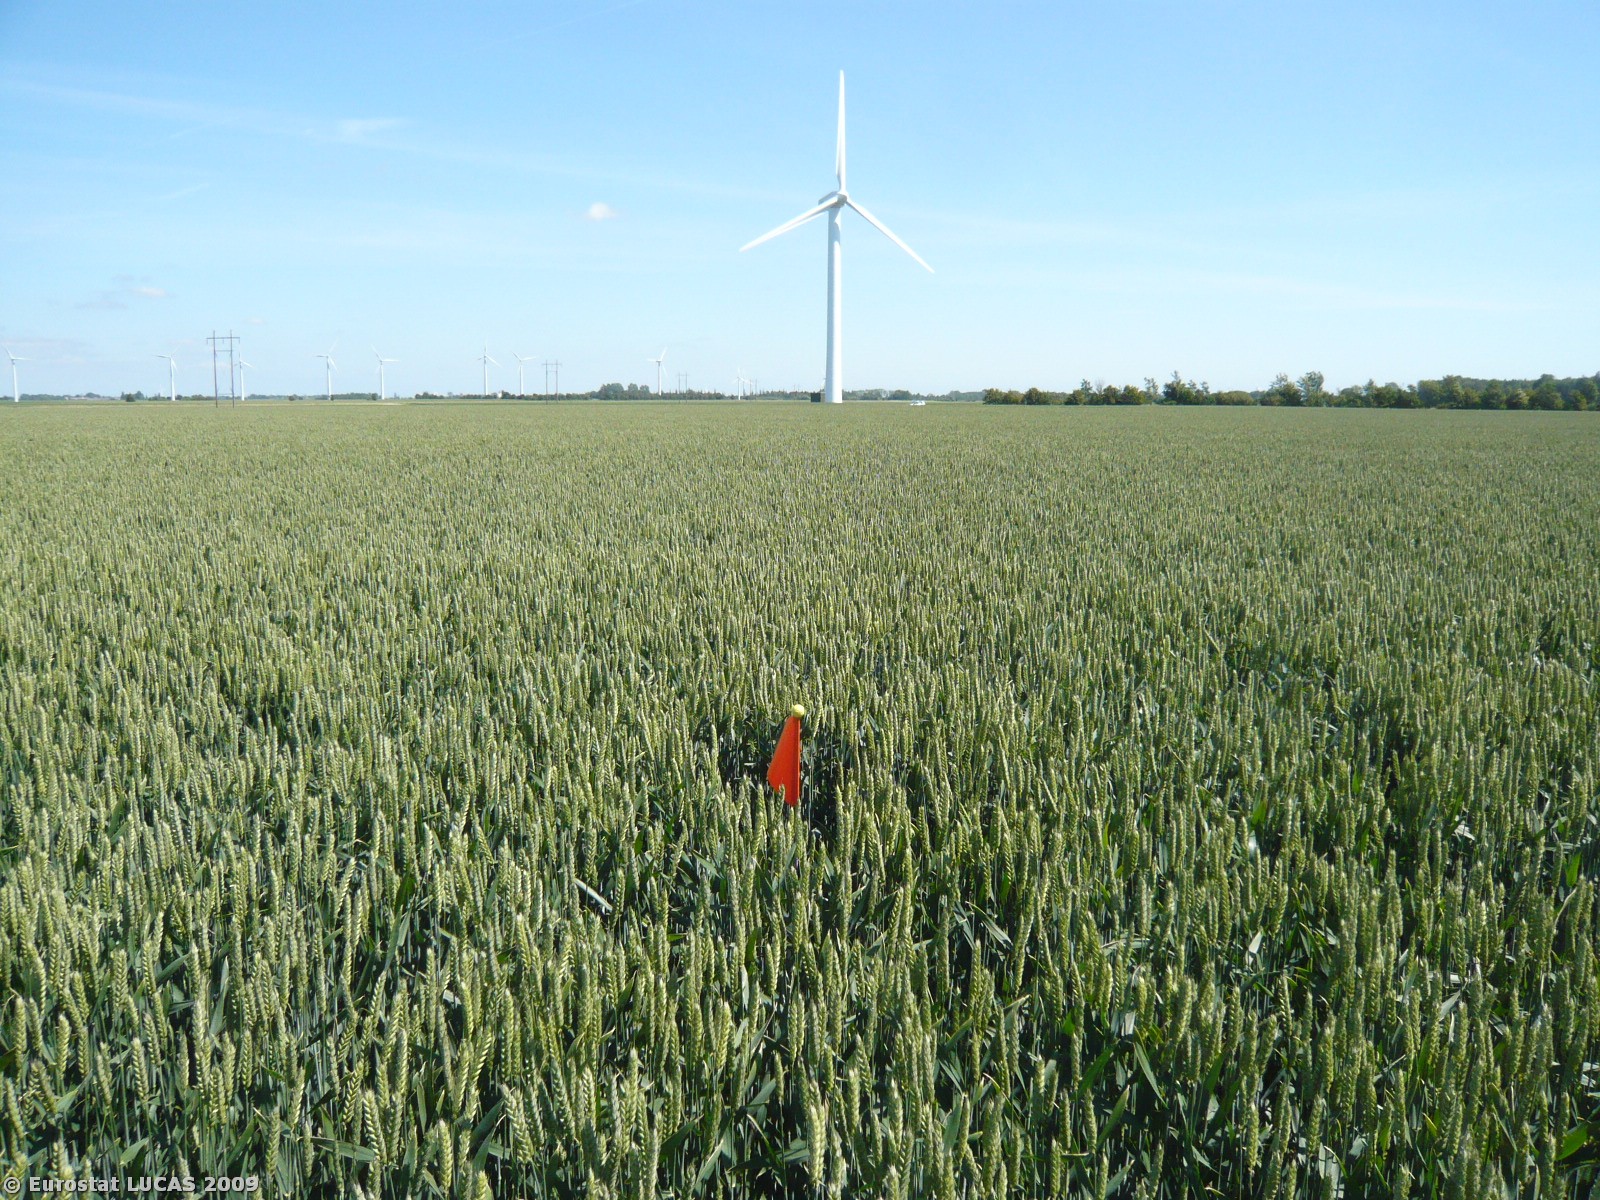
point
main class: Cropland
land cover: Common wheat
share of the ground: > 75 %
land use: Agriculture (excluding fallow land and kitchen gardens)
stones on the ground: < 10 %
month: June
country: DK
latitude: 54.7435
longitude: 11.2574
